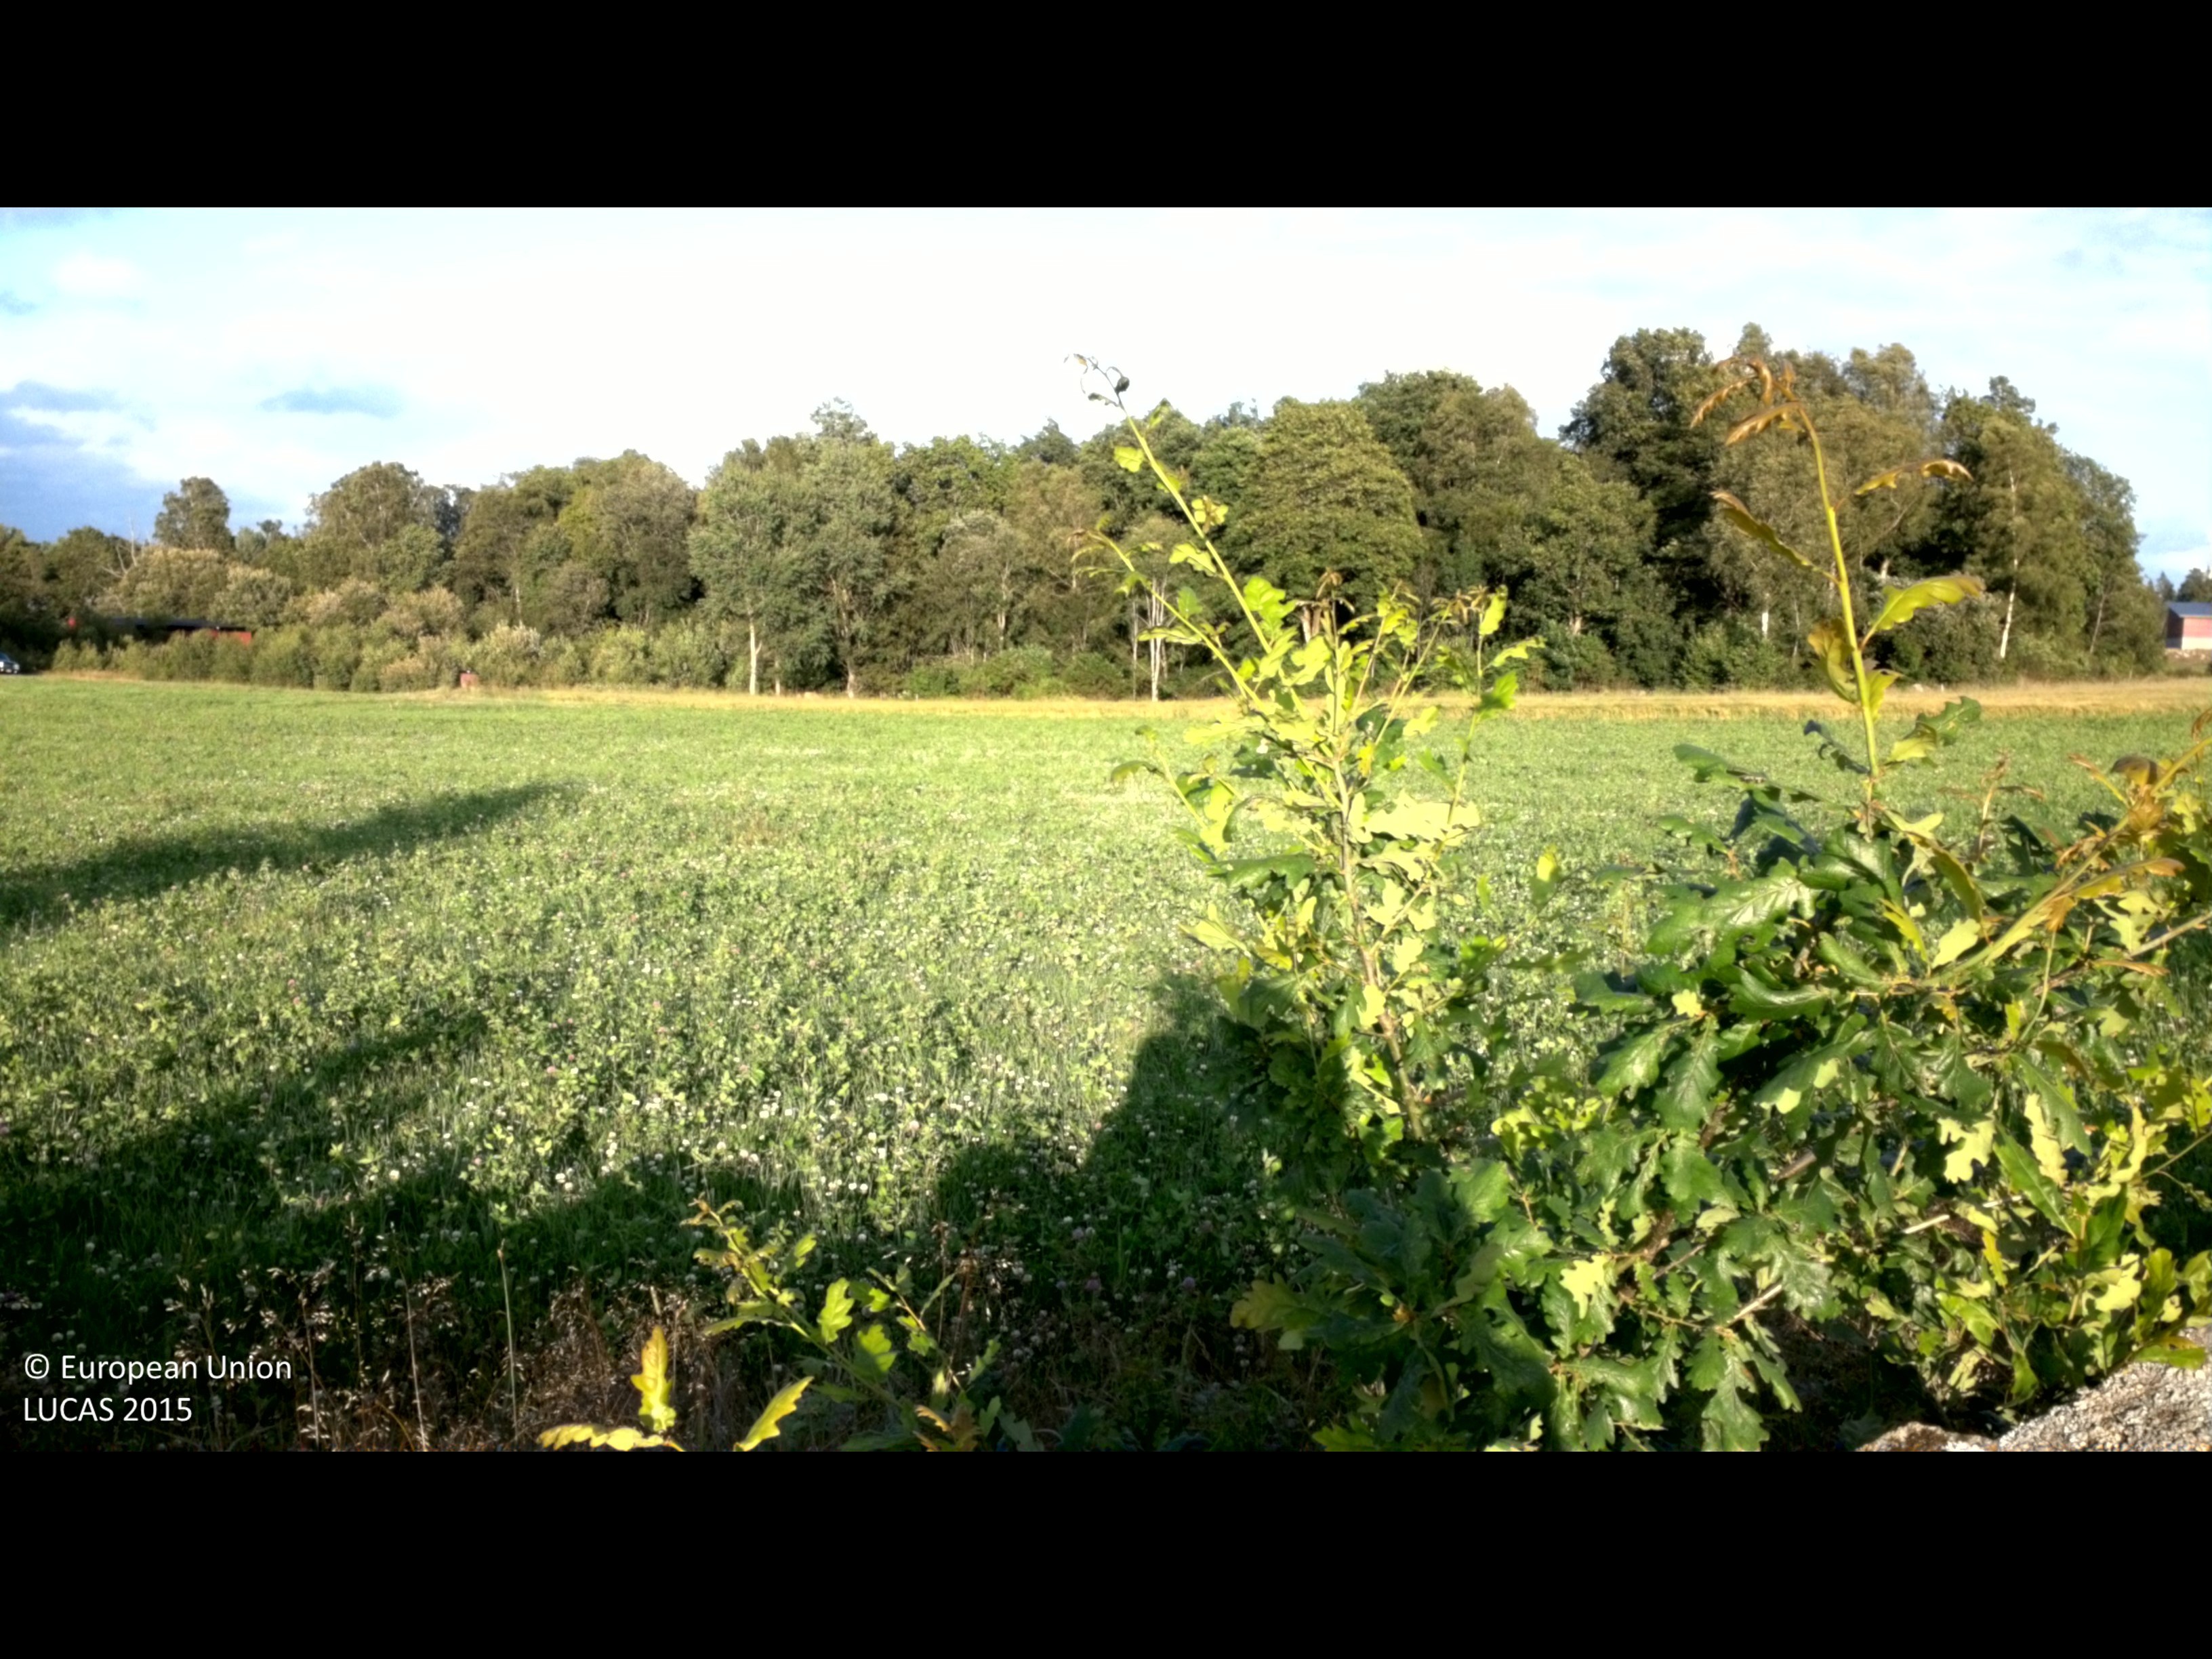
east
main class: Cropland
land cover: Common wheat
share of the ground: > 75 %
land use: Agriculture (excluding fallow land and kitchen gardens)
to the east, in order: Common wheat; Dry stone walls; Other leguminous and mixtures for fodder; Paved roads, cycling and walking lanes; Grass margins; Rye; Broadleaved woodland
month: July
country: SE
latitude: 56.8142
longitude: 13.8461
